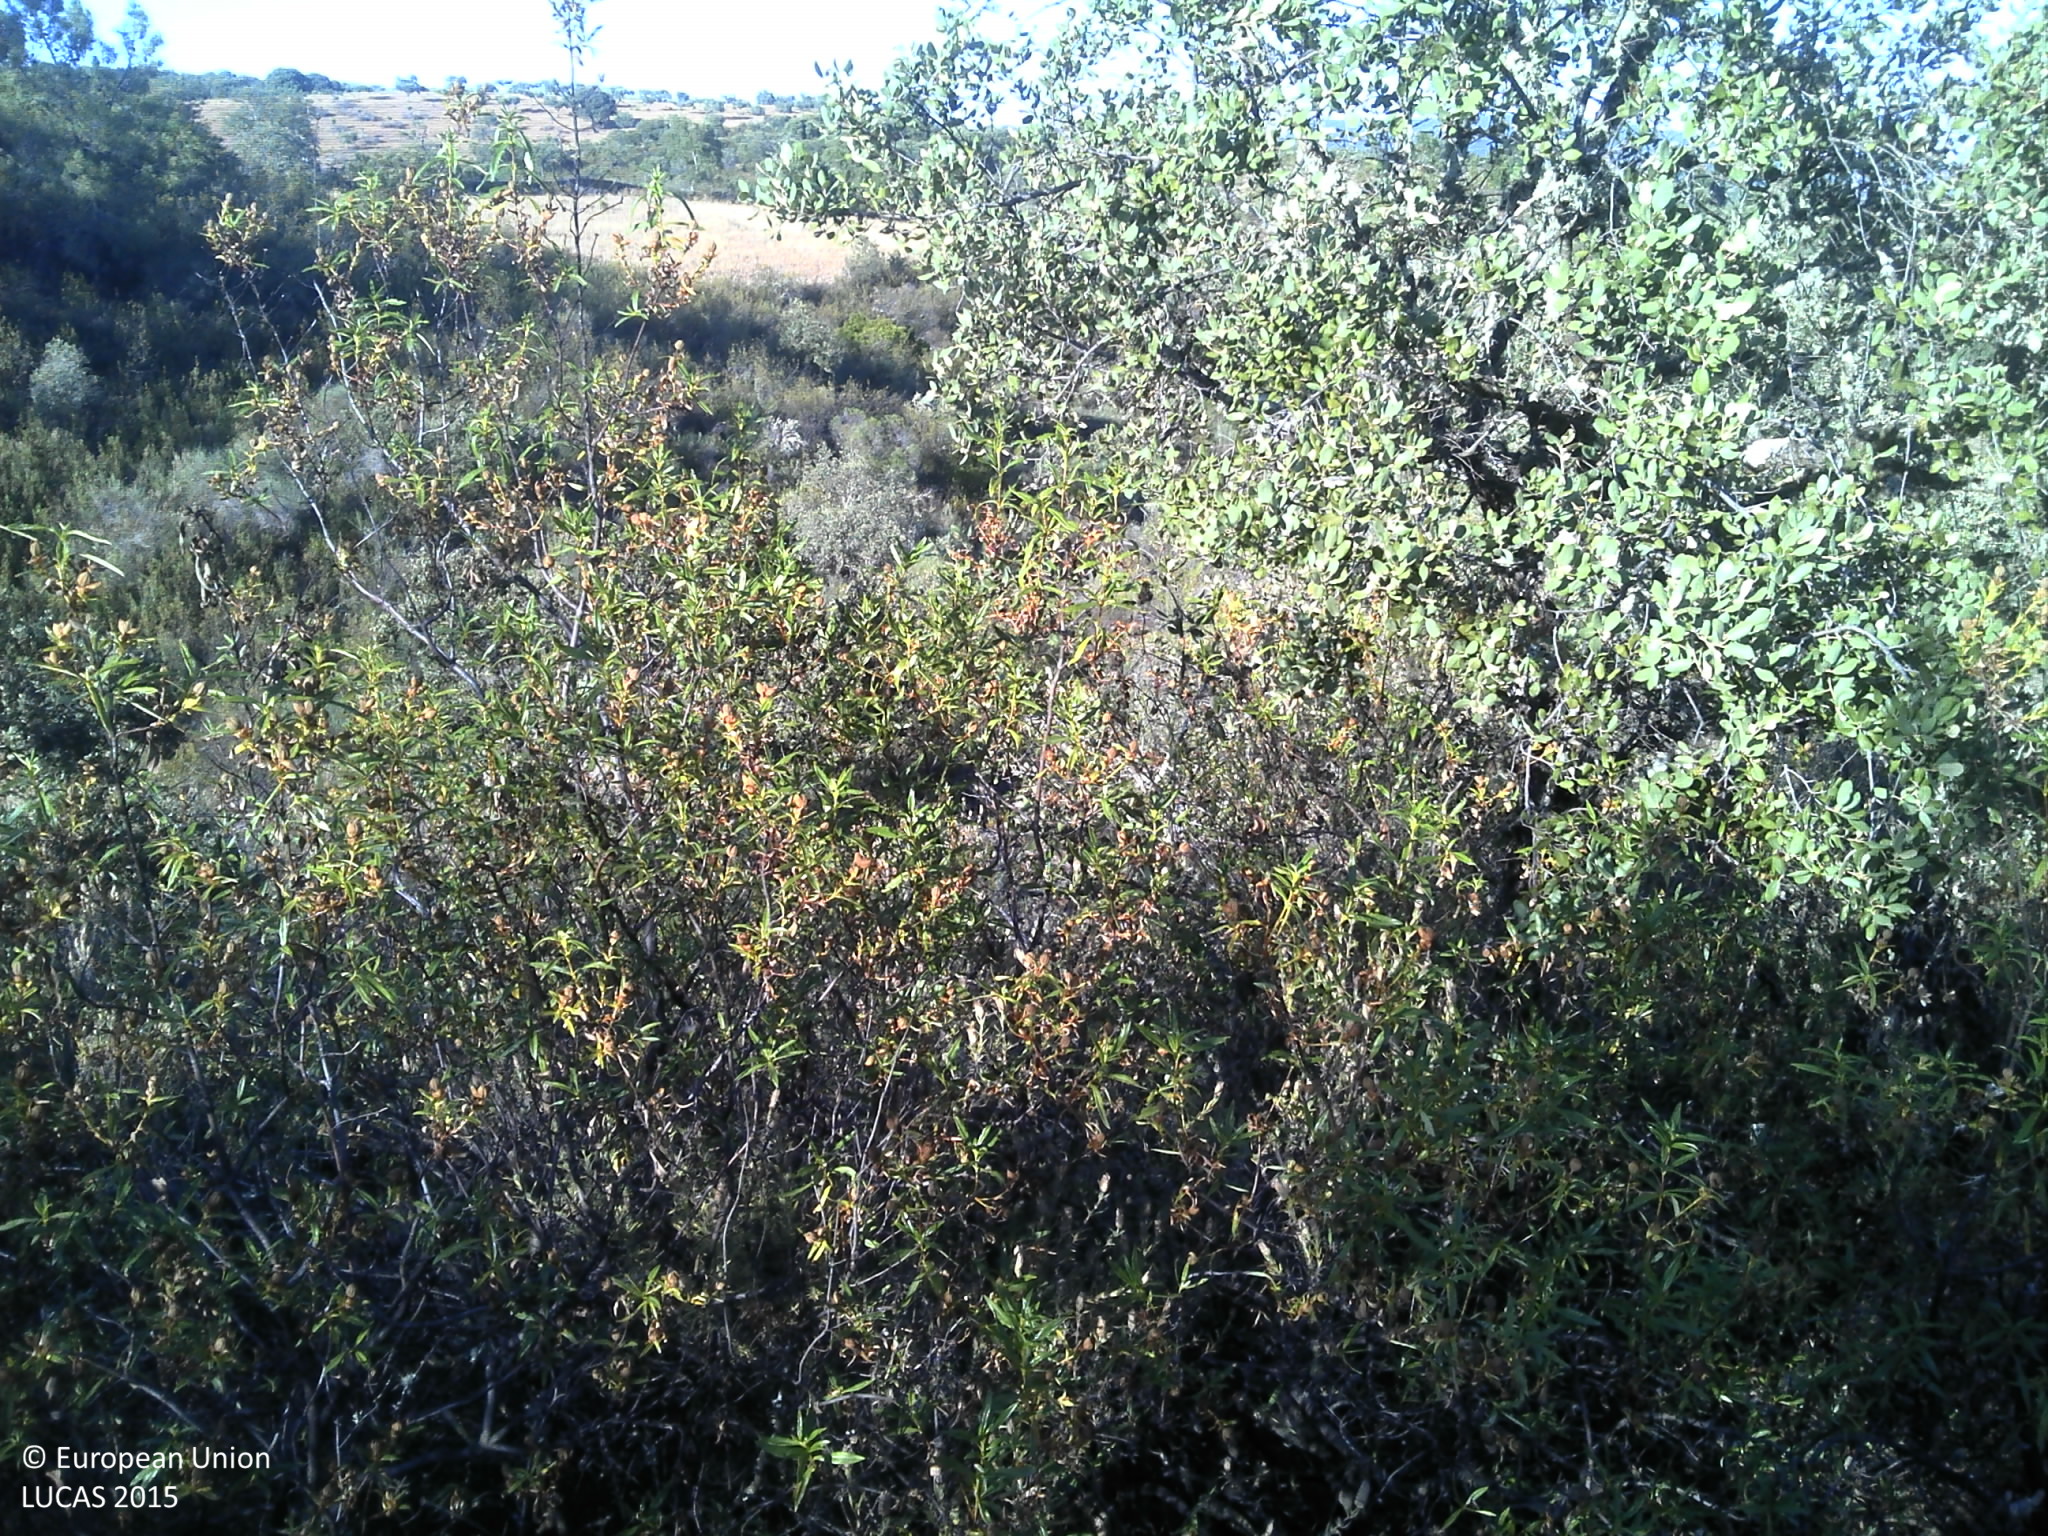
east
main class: Shrubland
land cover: Shrubland with sparse tree cover
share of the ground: 50 - 75 %
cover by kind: shrubs 75 %, herbaceous plants 10 %, coniferous forest trees 5 %, unconsolidated bare surface 5 %
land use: Forestry
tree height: > 5 m
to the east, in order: Shrubland with sparse tree cover; Olive groves; Grassland without tree/shrub cover; Abandoned hedges; Rivers and streams
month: June
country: PT
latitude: 39.9524
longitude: -7.0995
